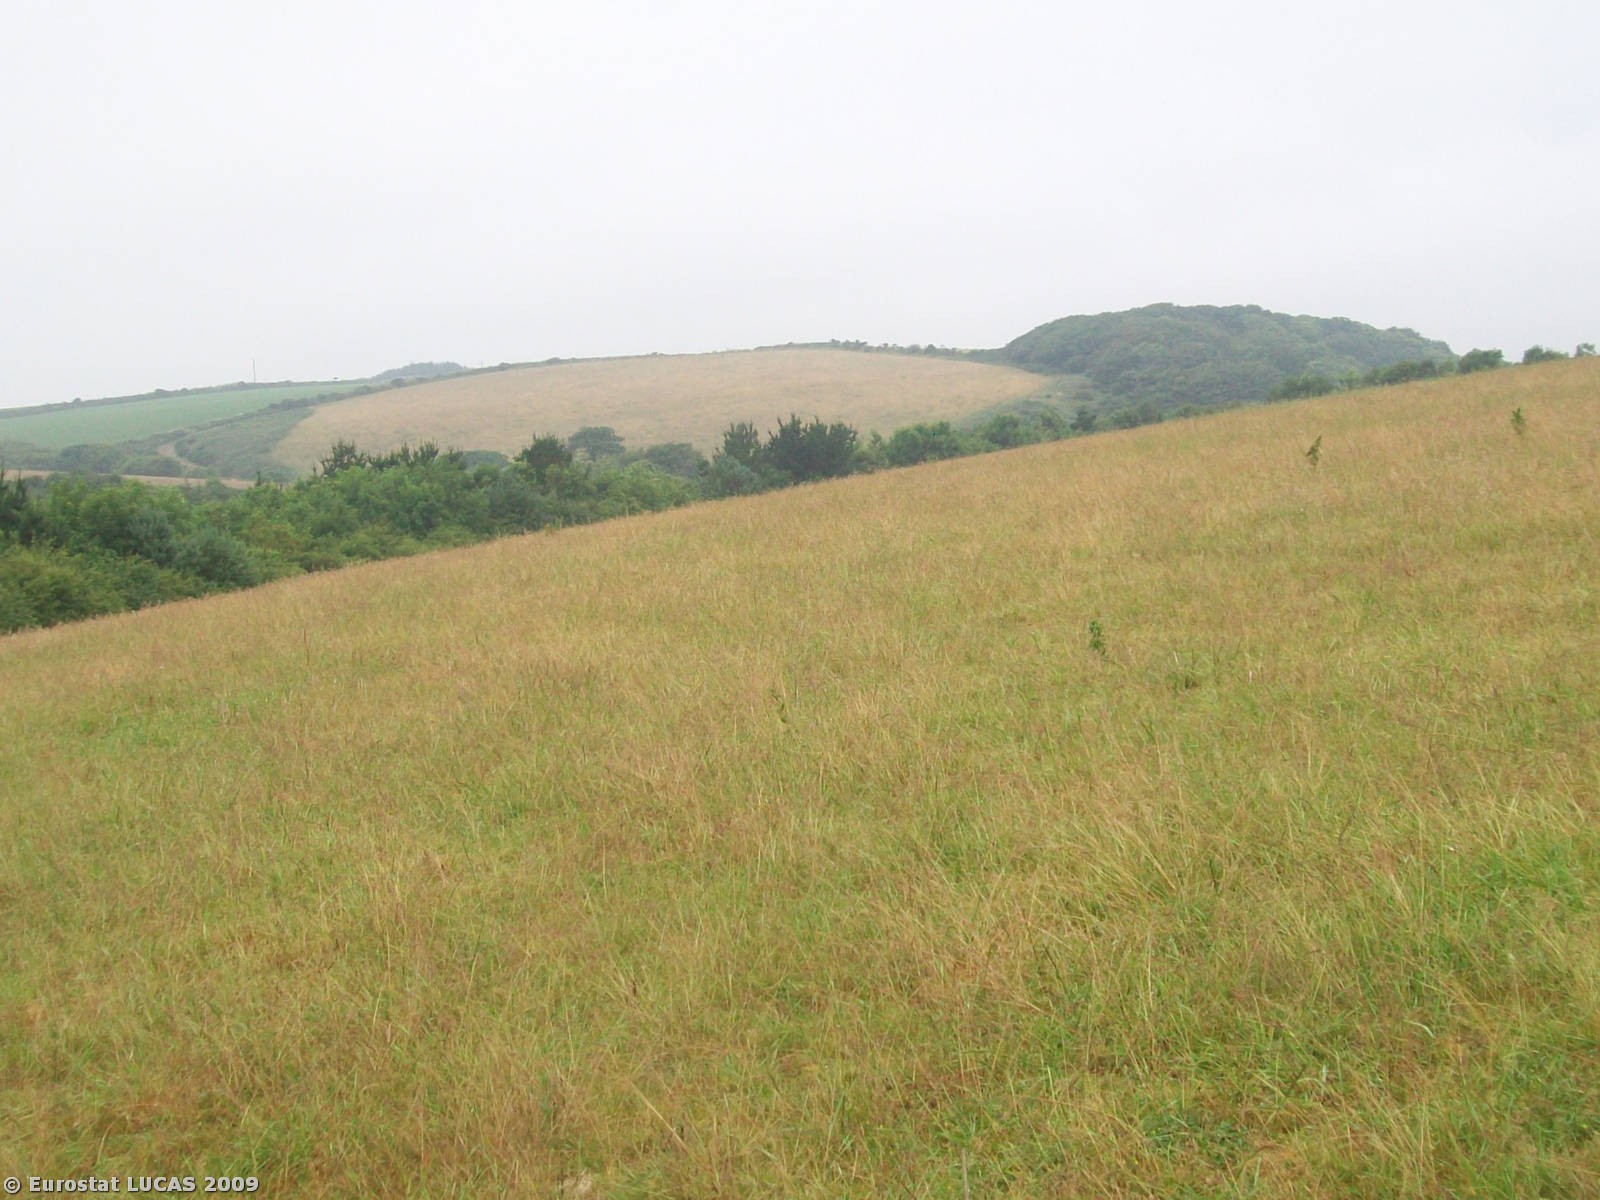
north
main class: Grassland
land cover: Grassland without tree/shrub cover
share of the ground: > 75 %
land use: Agriculture (excluding fallow land and kitchen gardens)
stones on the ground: < 10 %
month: July
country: GB
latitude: 50.3019
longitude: -5.1269
